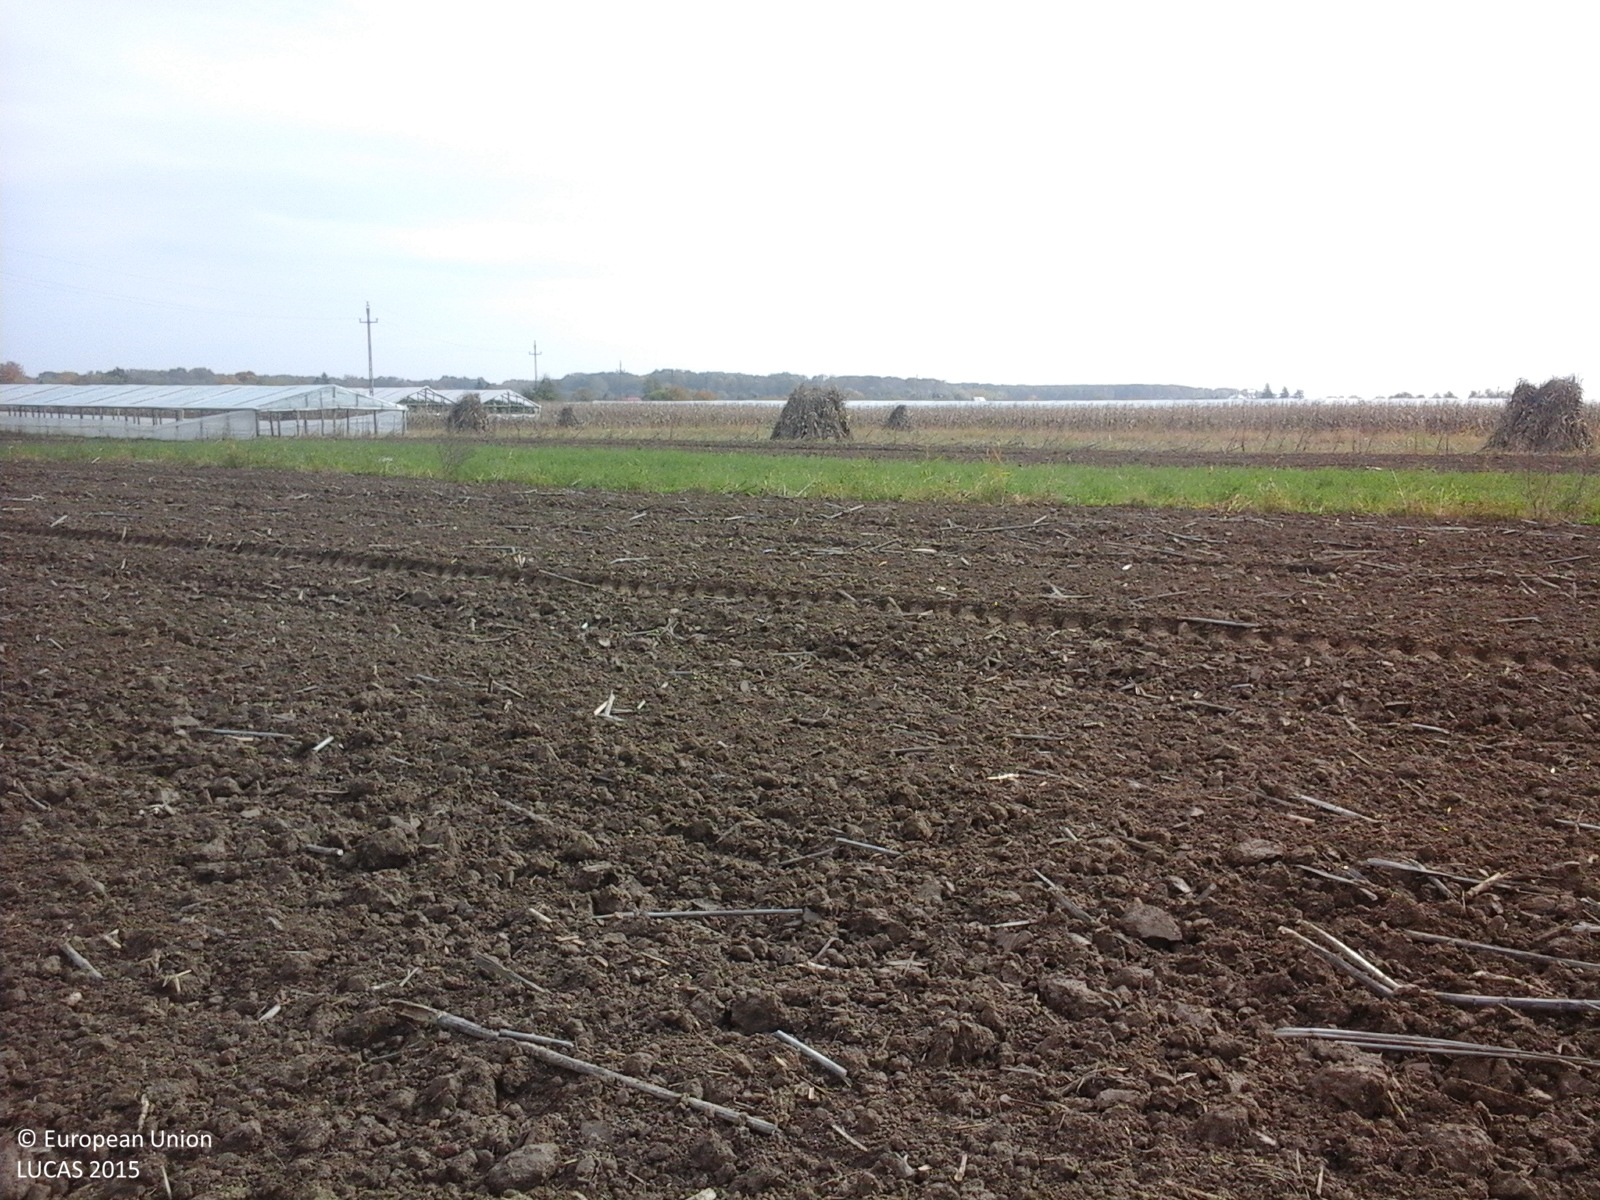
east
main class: Cropland
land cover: Maize
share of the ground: < 10 %
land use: Agriculture (excluding fallow land and kitchen gardens)
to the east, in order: Maize; Lucerne; Other bare soil; Maize; Dry pulses; Other fresh vegetables; Dry pulses; Maize; Electric lines; Maize
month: October
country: RO
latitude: 44.8362
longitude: 26.1633
